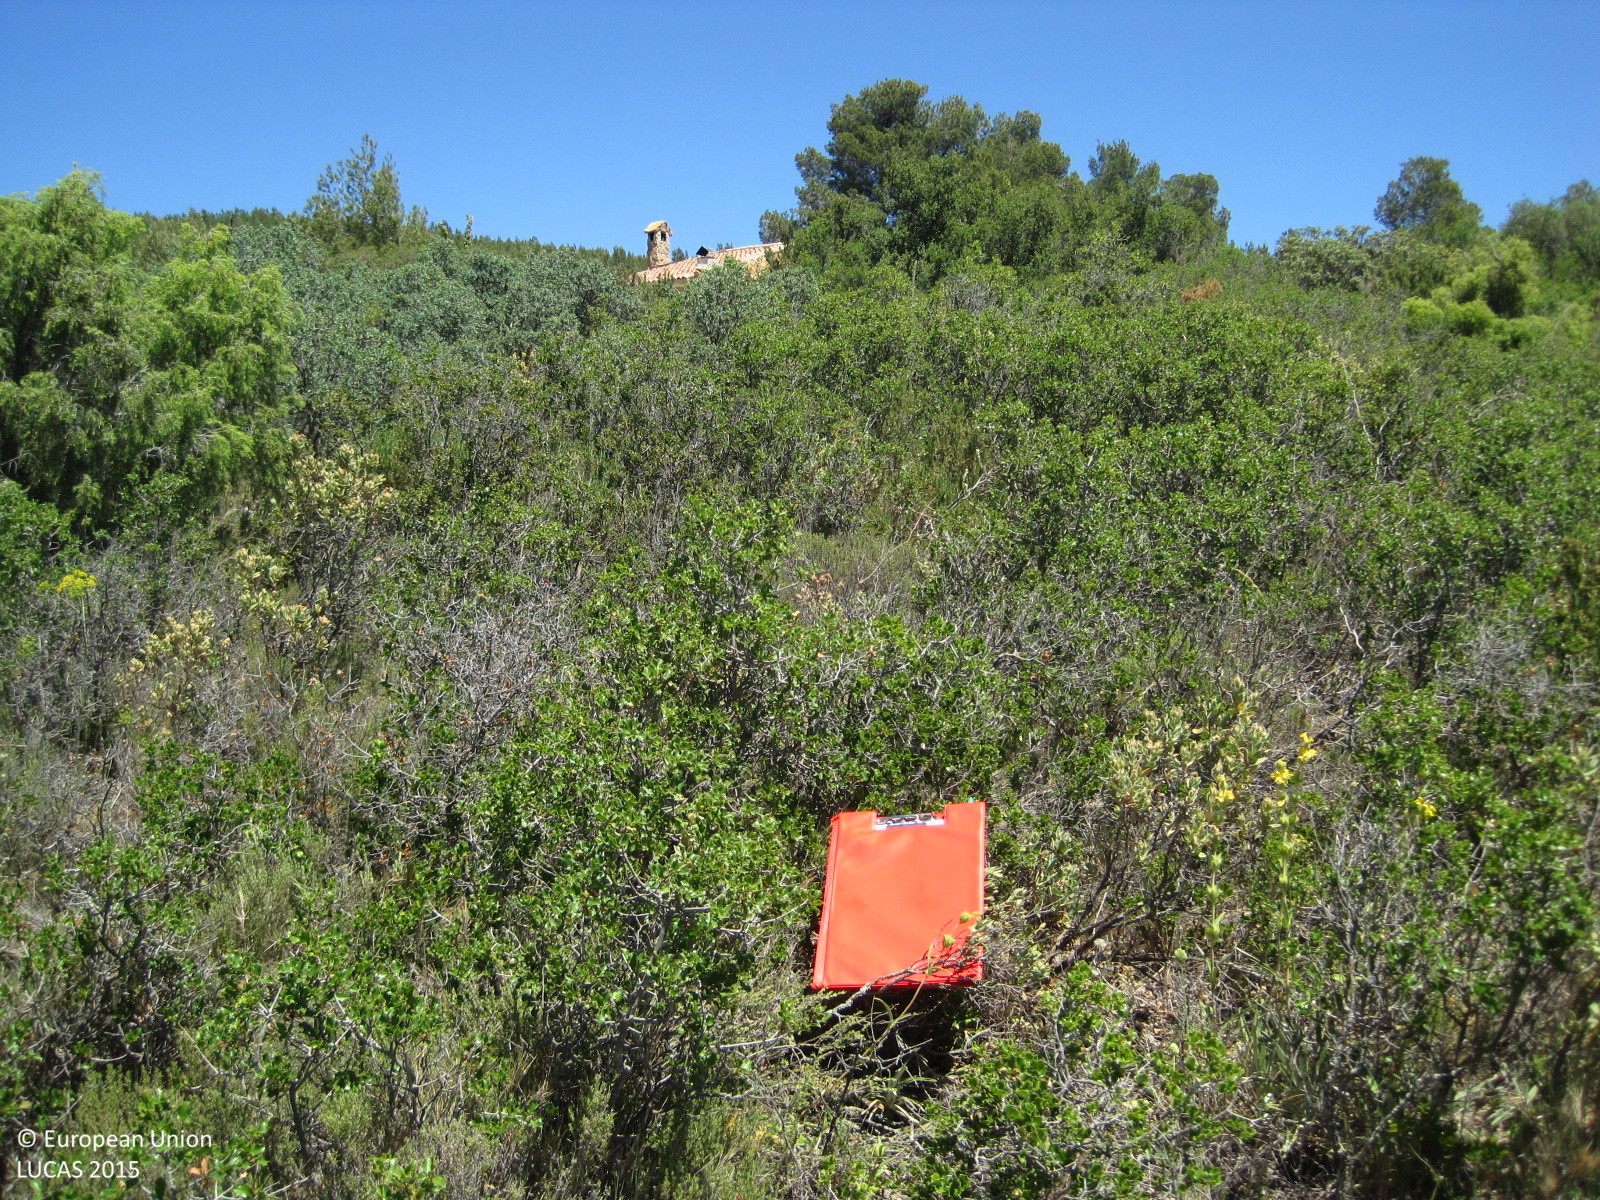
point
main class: Shrubland
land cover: Shrubland without tree cover
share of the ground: > 75 %
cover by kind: shrubs 95 %, consolidated bare surface 5 %
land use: Semi-natural and natural areas not in use
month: May
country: ES
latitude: 39.4254
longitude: -0.8607
